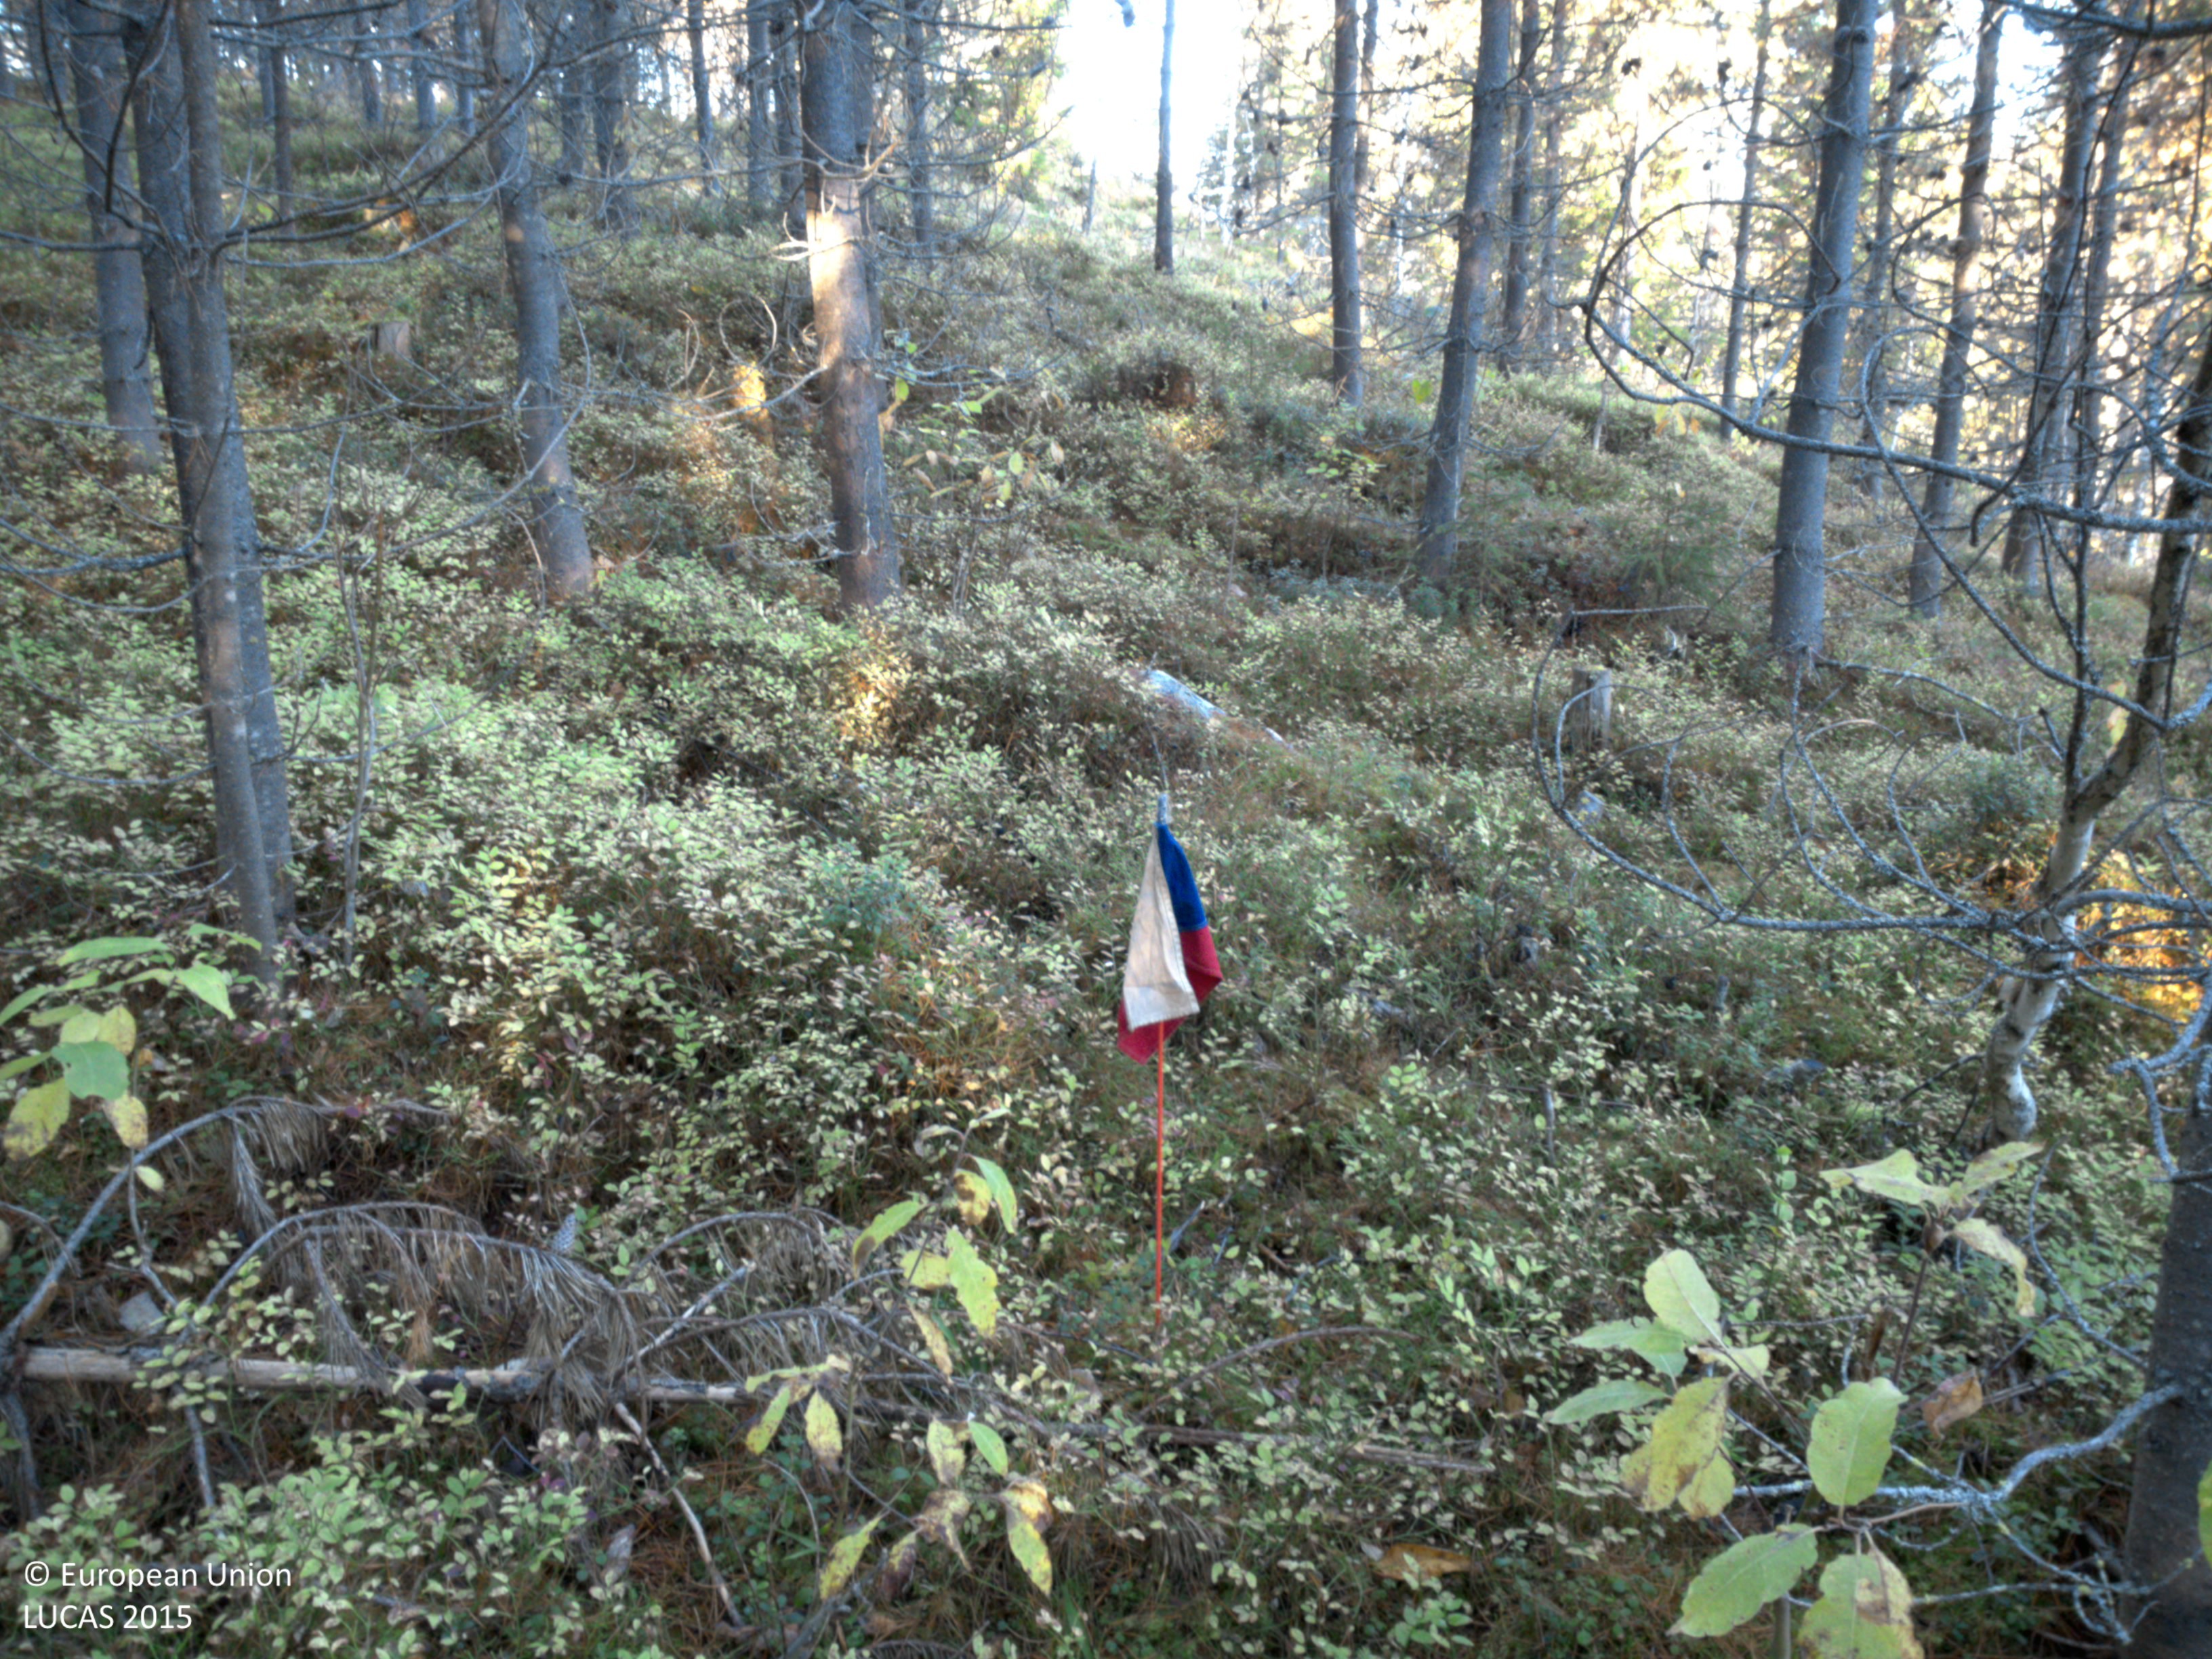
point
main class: Woodland
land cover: Pine dominated coniferous woodland
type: exotic forest
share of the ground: 50 - 75 %
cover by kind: coniferous forest trees 60 %, shrubs 25 %, lichens and mosses 10 %, broadleaved forest trees 5 %
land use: Forestry
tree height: > 5 m
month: October
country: SE
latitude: 64.8585
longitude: 17.8332
